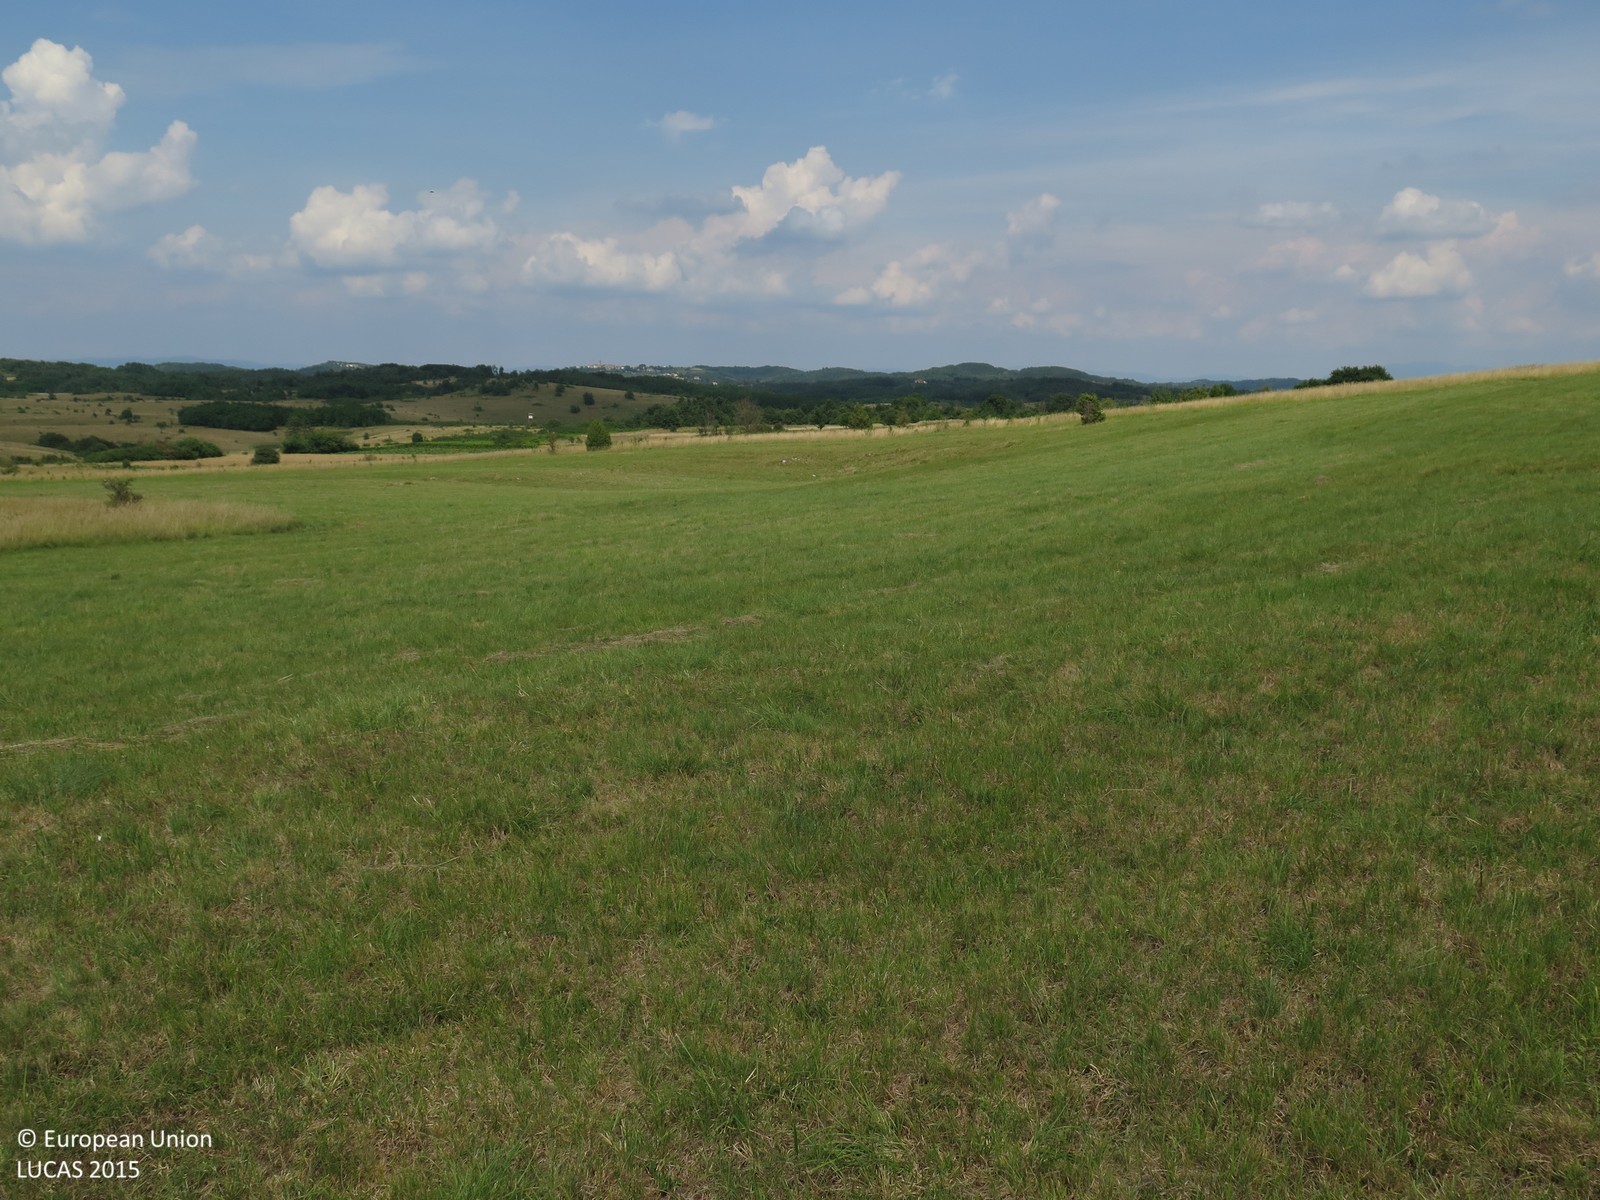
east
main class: Grassland
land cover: Grassland without tree/shrub cover
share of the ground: > 75 %
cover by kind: herbaceous plants 100 %
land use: Agriculture (excluding fallow land and kitchen gardens)
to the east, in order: Grassland without tree/shrub cover; Common wheat; Tracks; Grassland without tree/shrub cover
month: June
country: HR
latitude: 45.2734
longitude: 13.8061
